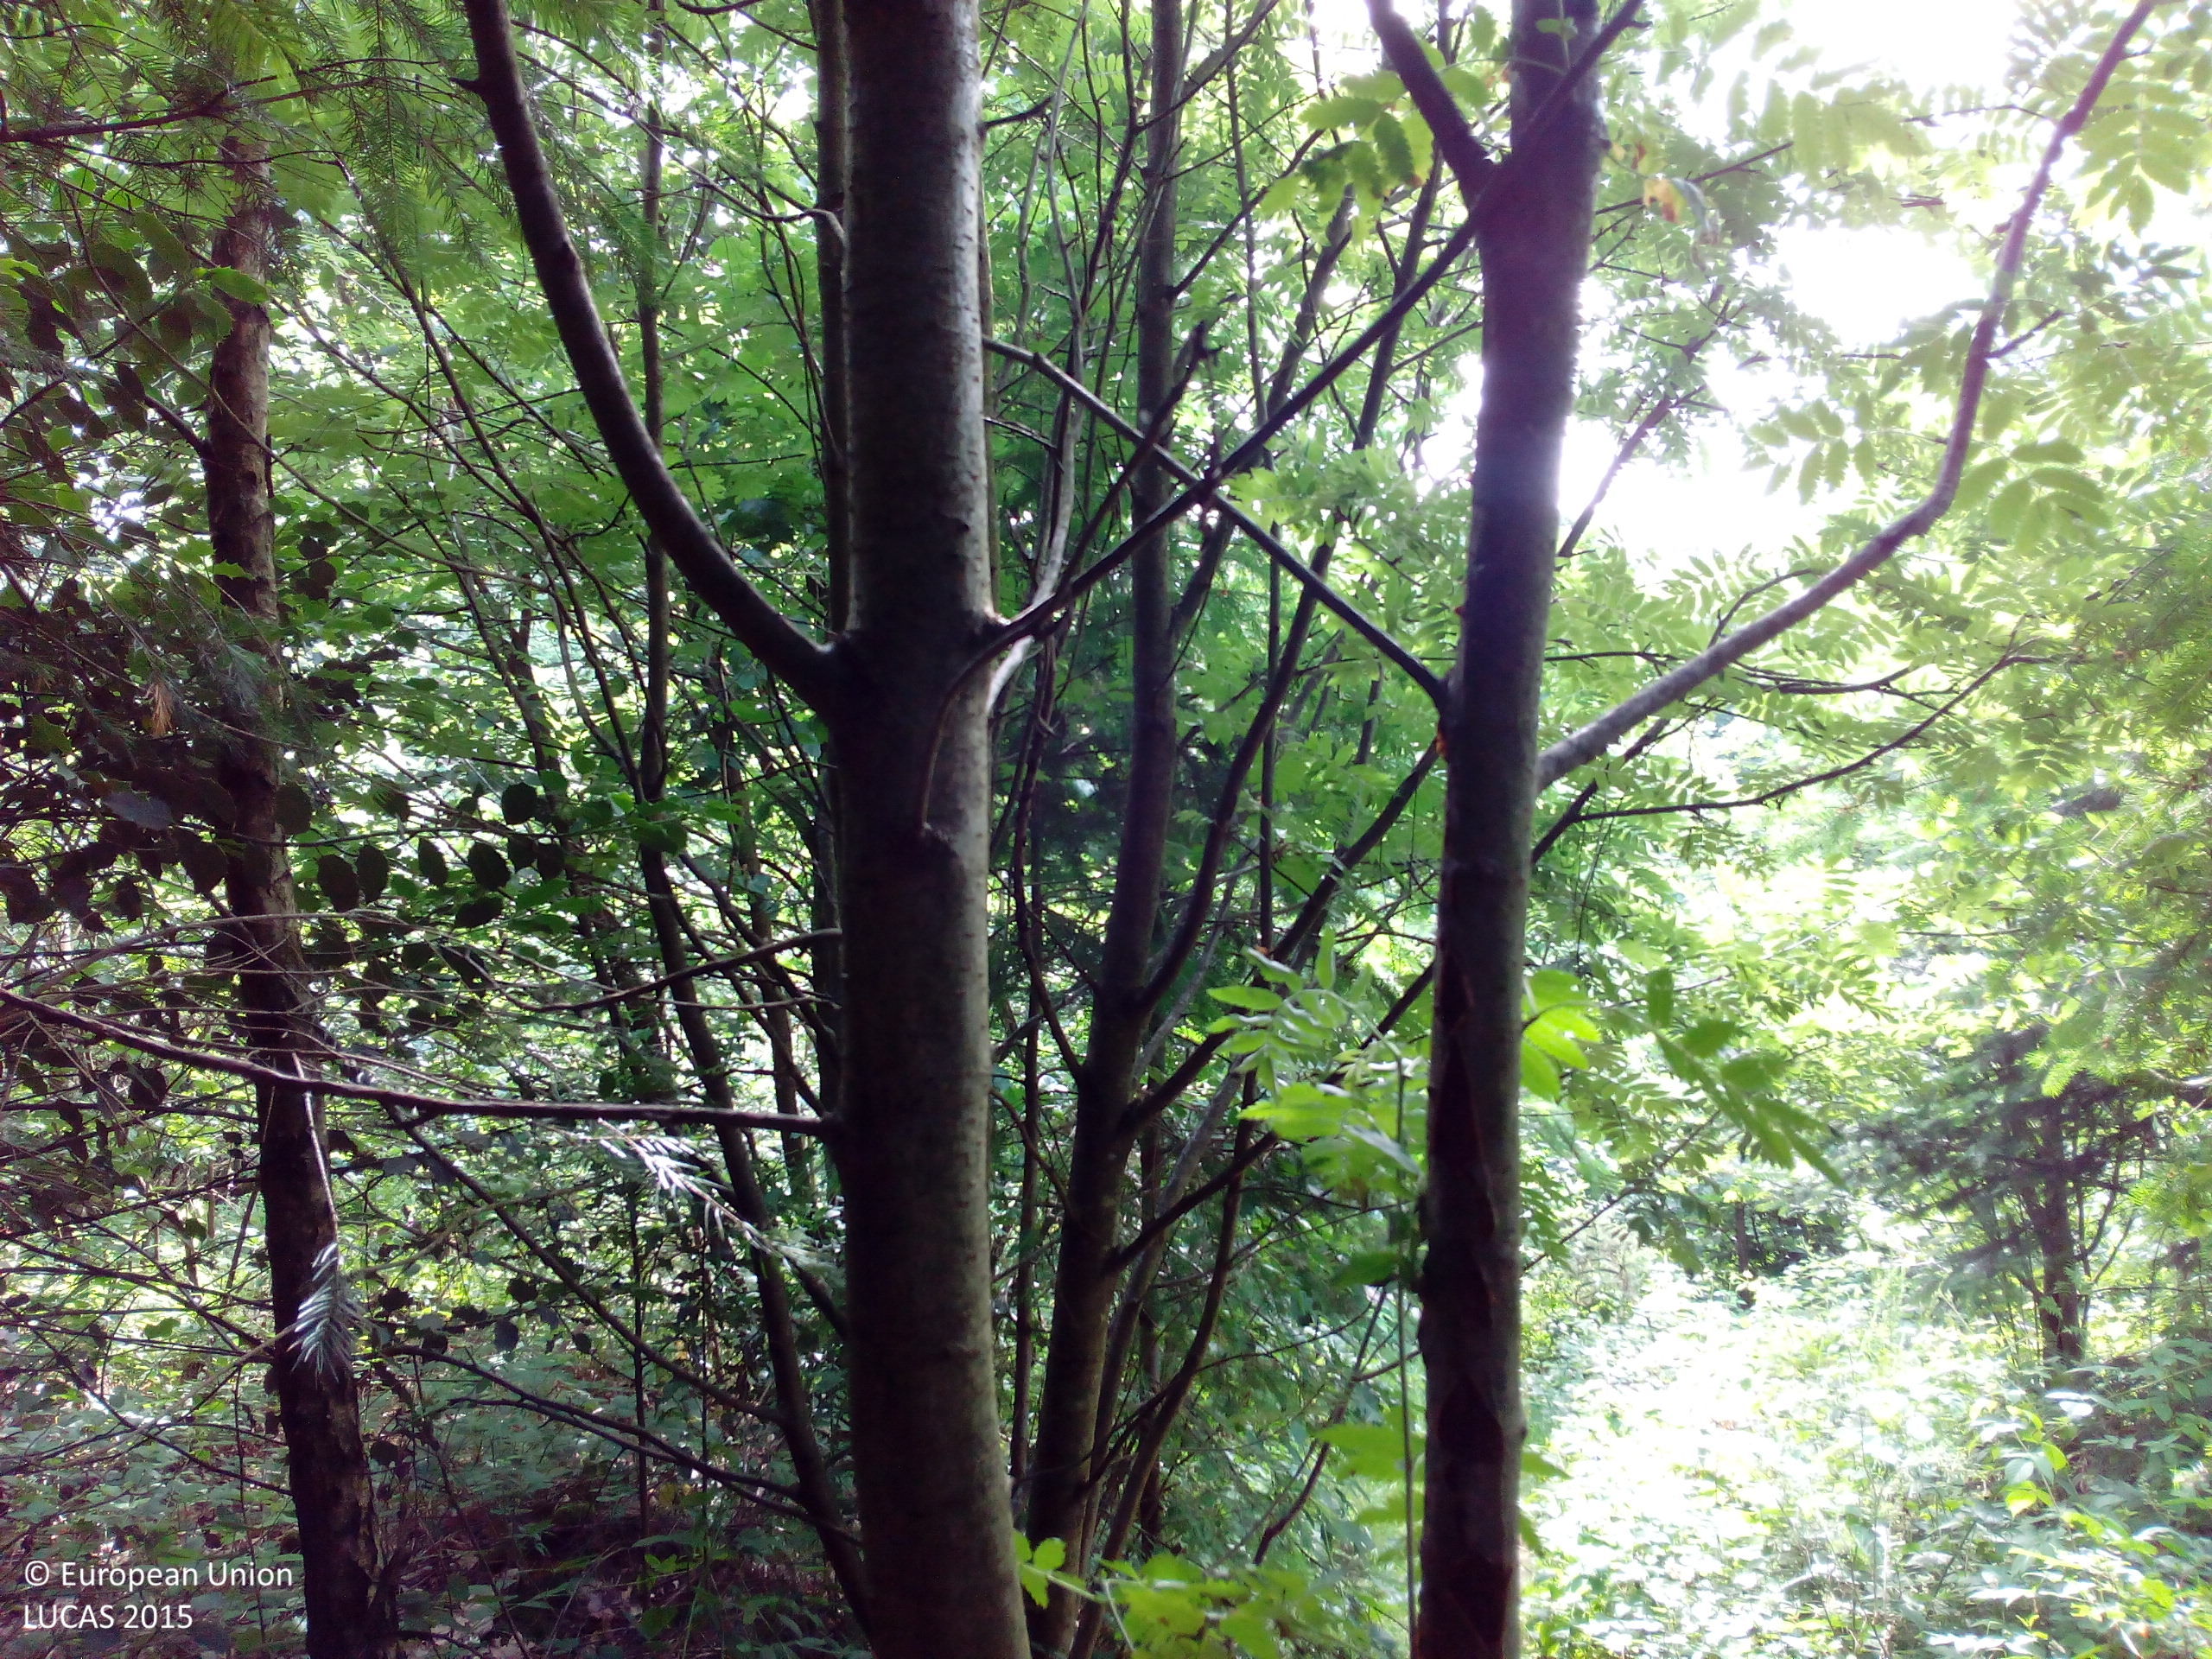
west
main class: Woodland
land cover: Spruce dominated mixed woodland
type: hemiboreal forest and nemoral coniferous forest and mixed broadleaved-coniferous forest
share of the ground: > 75 %
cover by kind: coniferous forest trees 60 %, broadleaved forest trees 40 %
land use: Forestry
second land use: Amenities, museums, leisure
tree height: > 5 m
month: June
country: DE
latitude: 48.7307
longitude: 8.1925
